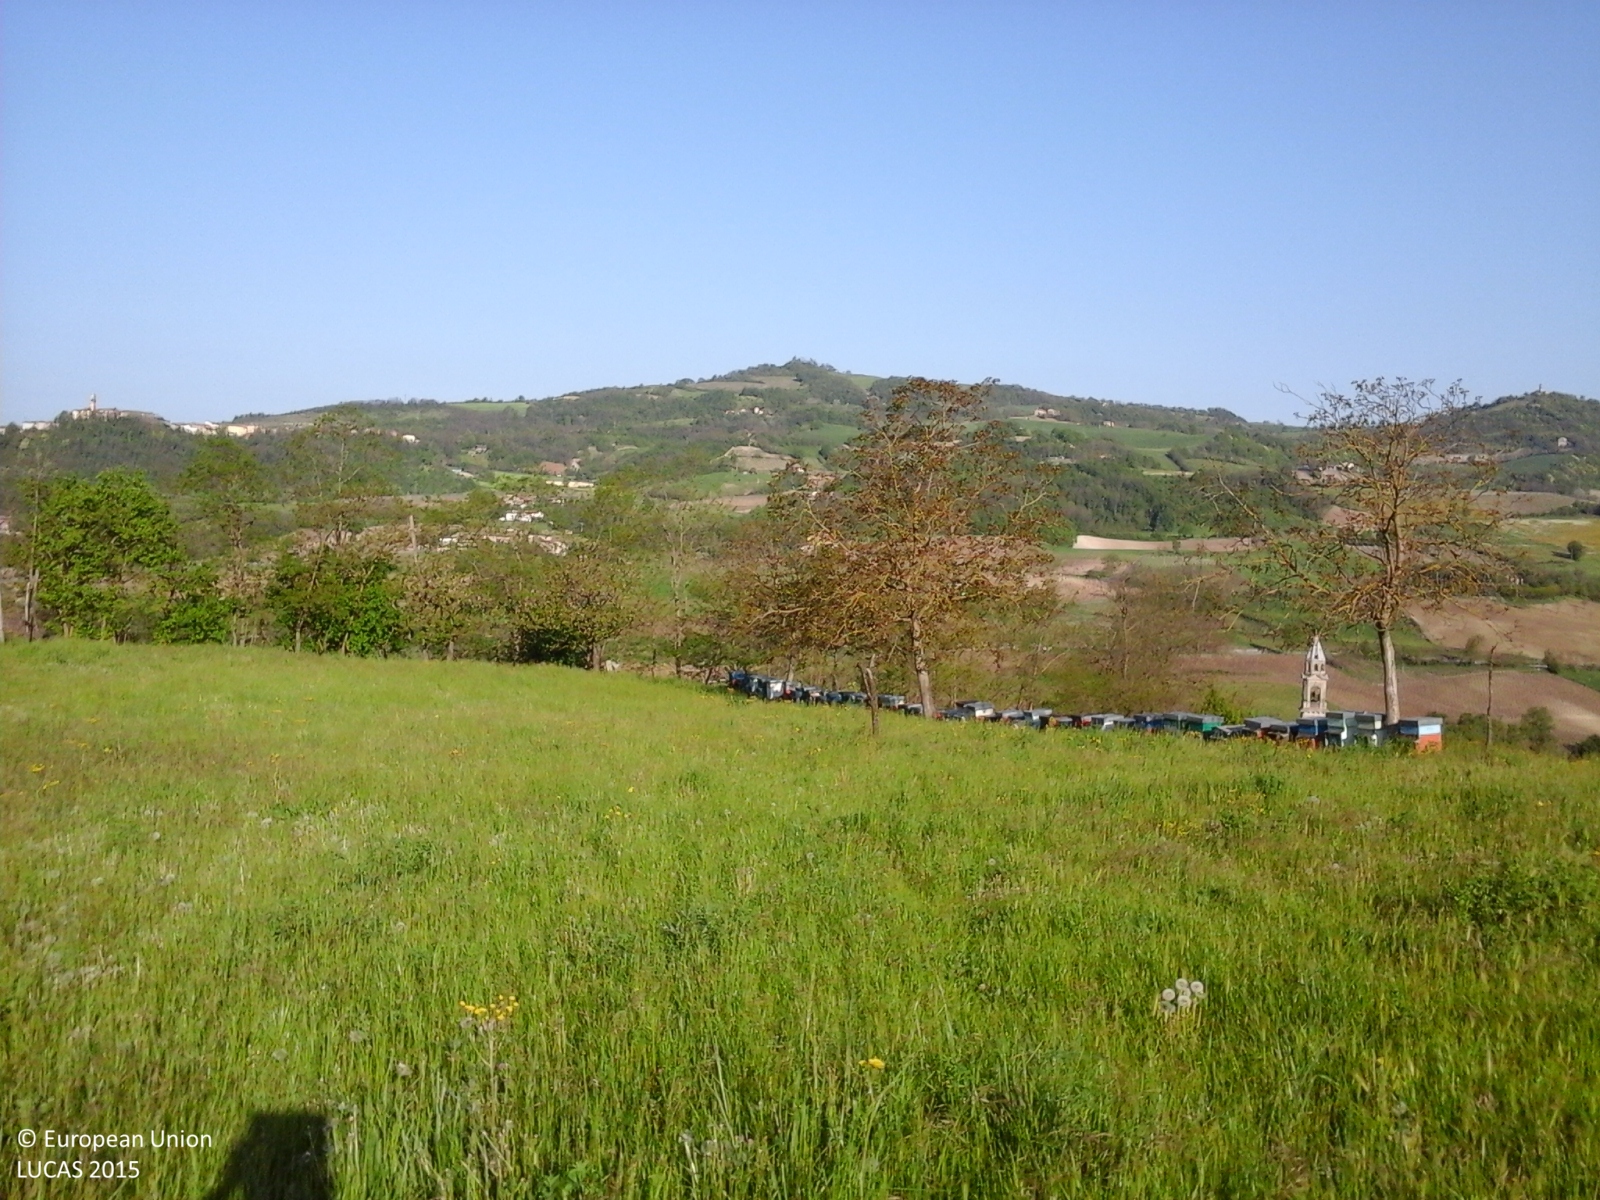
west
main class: Grassland
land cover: Grassland without tree/shrub cover
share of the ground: > 75 %
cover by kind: herbaceous plants 100 %
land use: Agriculture (excluding fallow land and kitchen gardens)
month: April
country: IT
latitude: 44.9258
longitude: 9.3804
